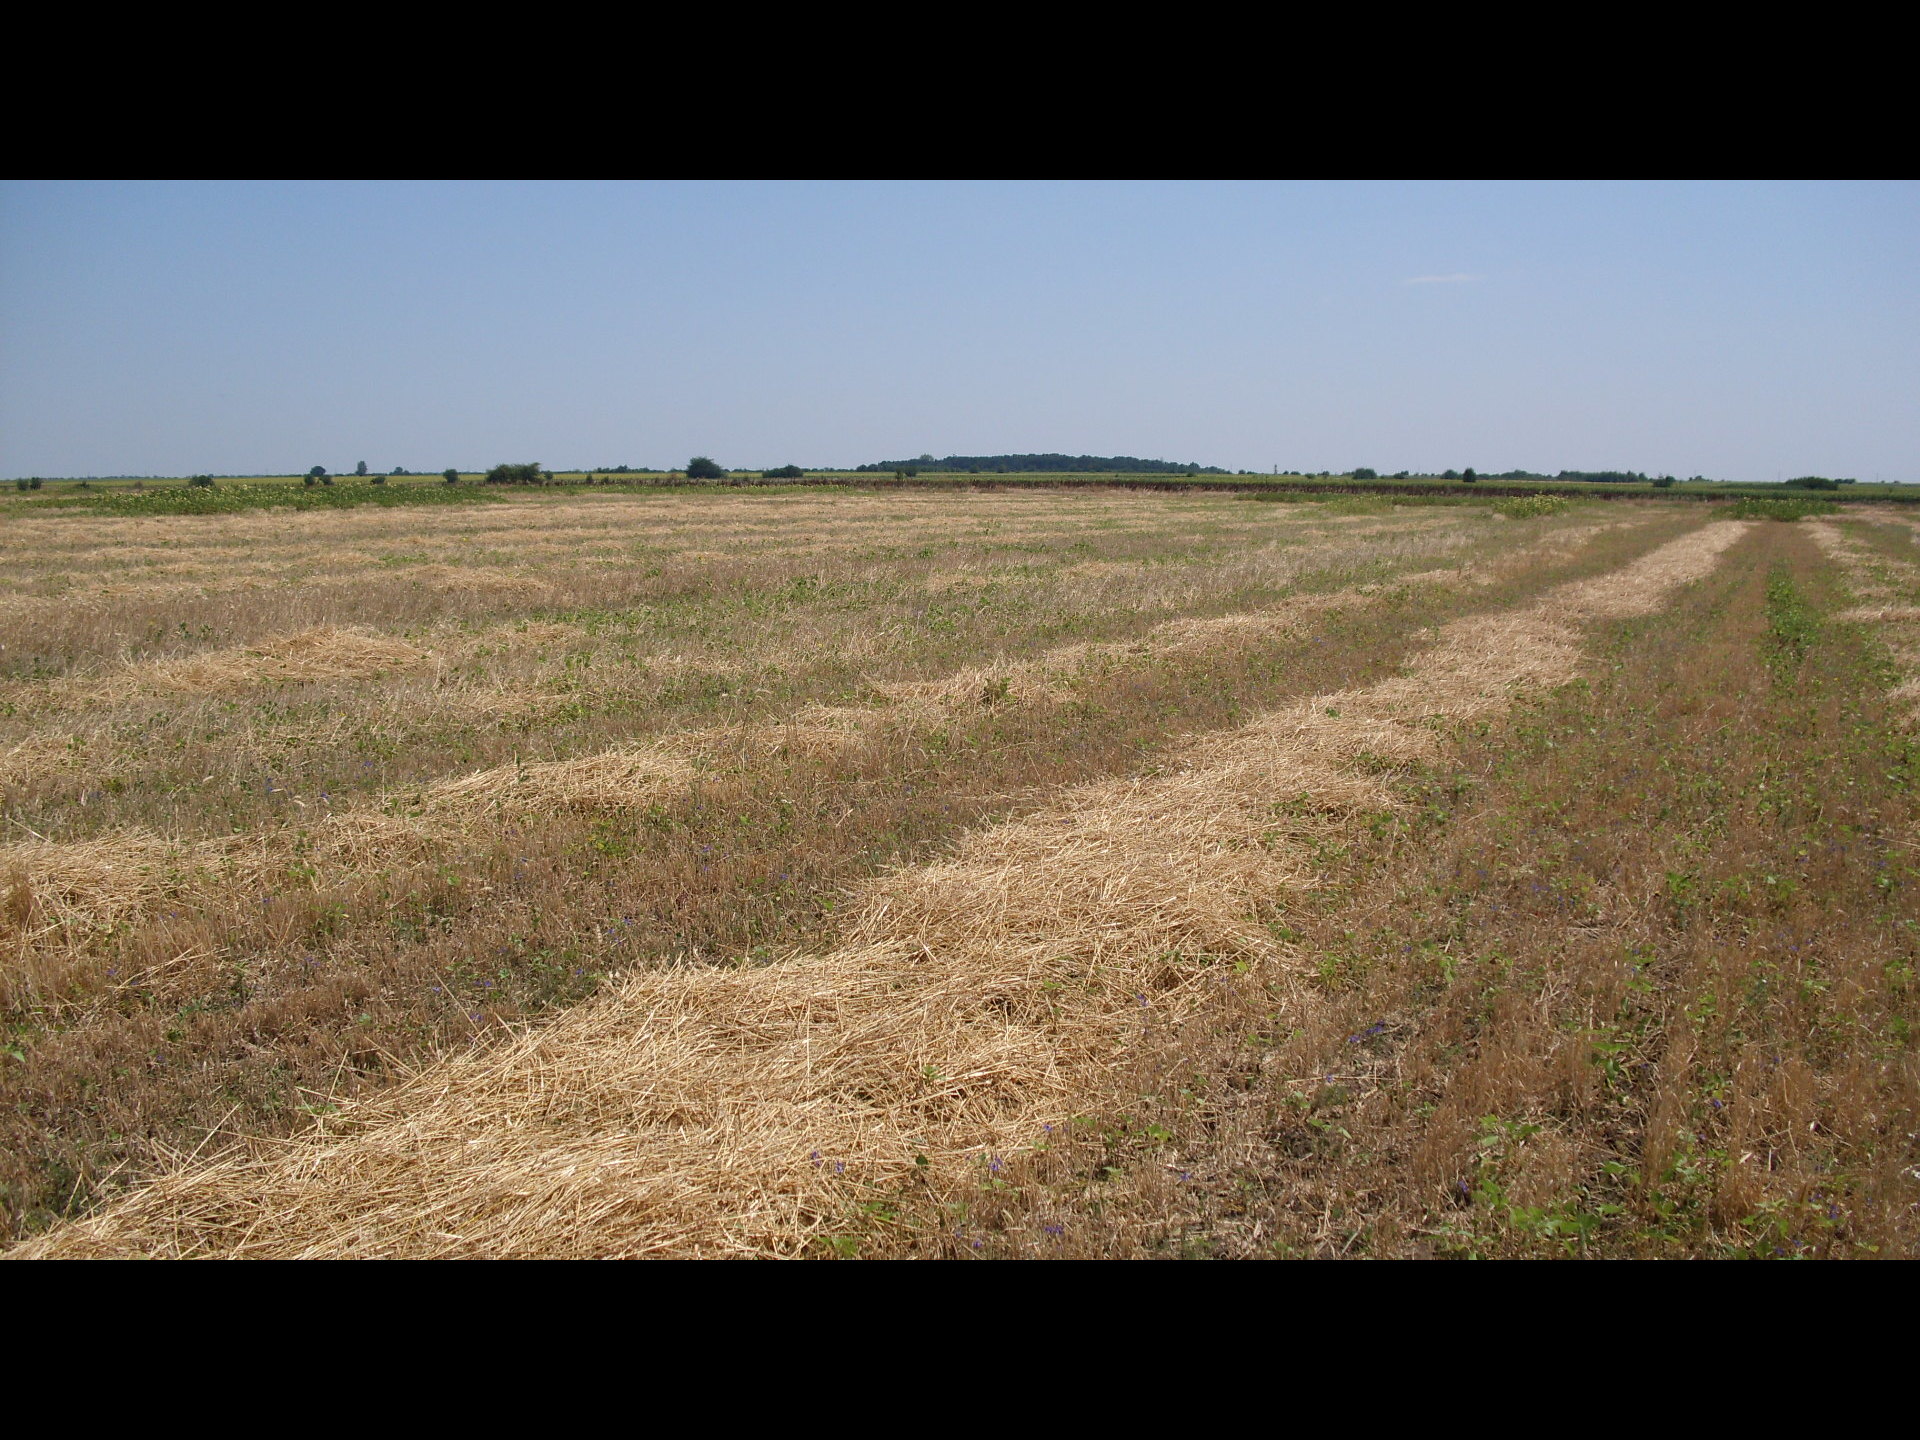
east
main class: Cropland
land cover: Common wheat
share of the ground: > 75 %
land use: Agriculture (excluding fallow land and kitchen gardens)
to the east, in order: Common wheat; Grass margins; Tracks; Spontaneously vegetated surfaces
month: July
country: BG
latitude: 43.6529
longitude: 23.1714
